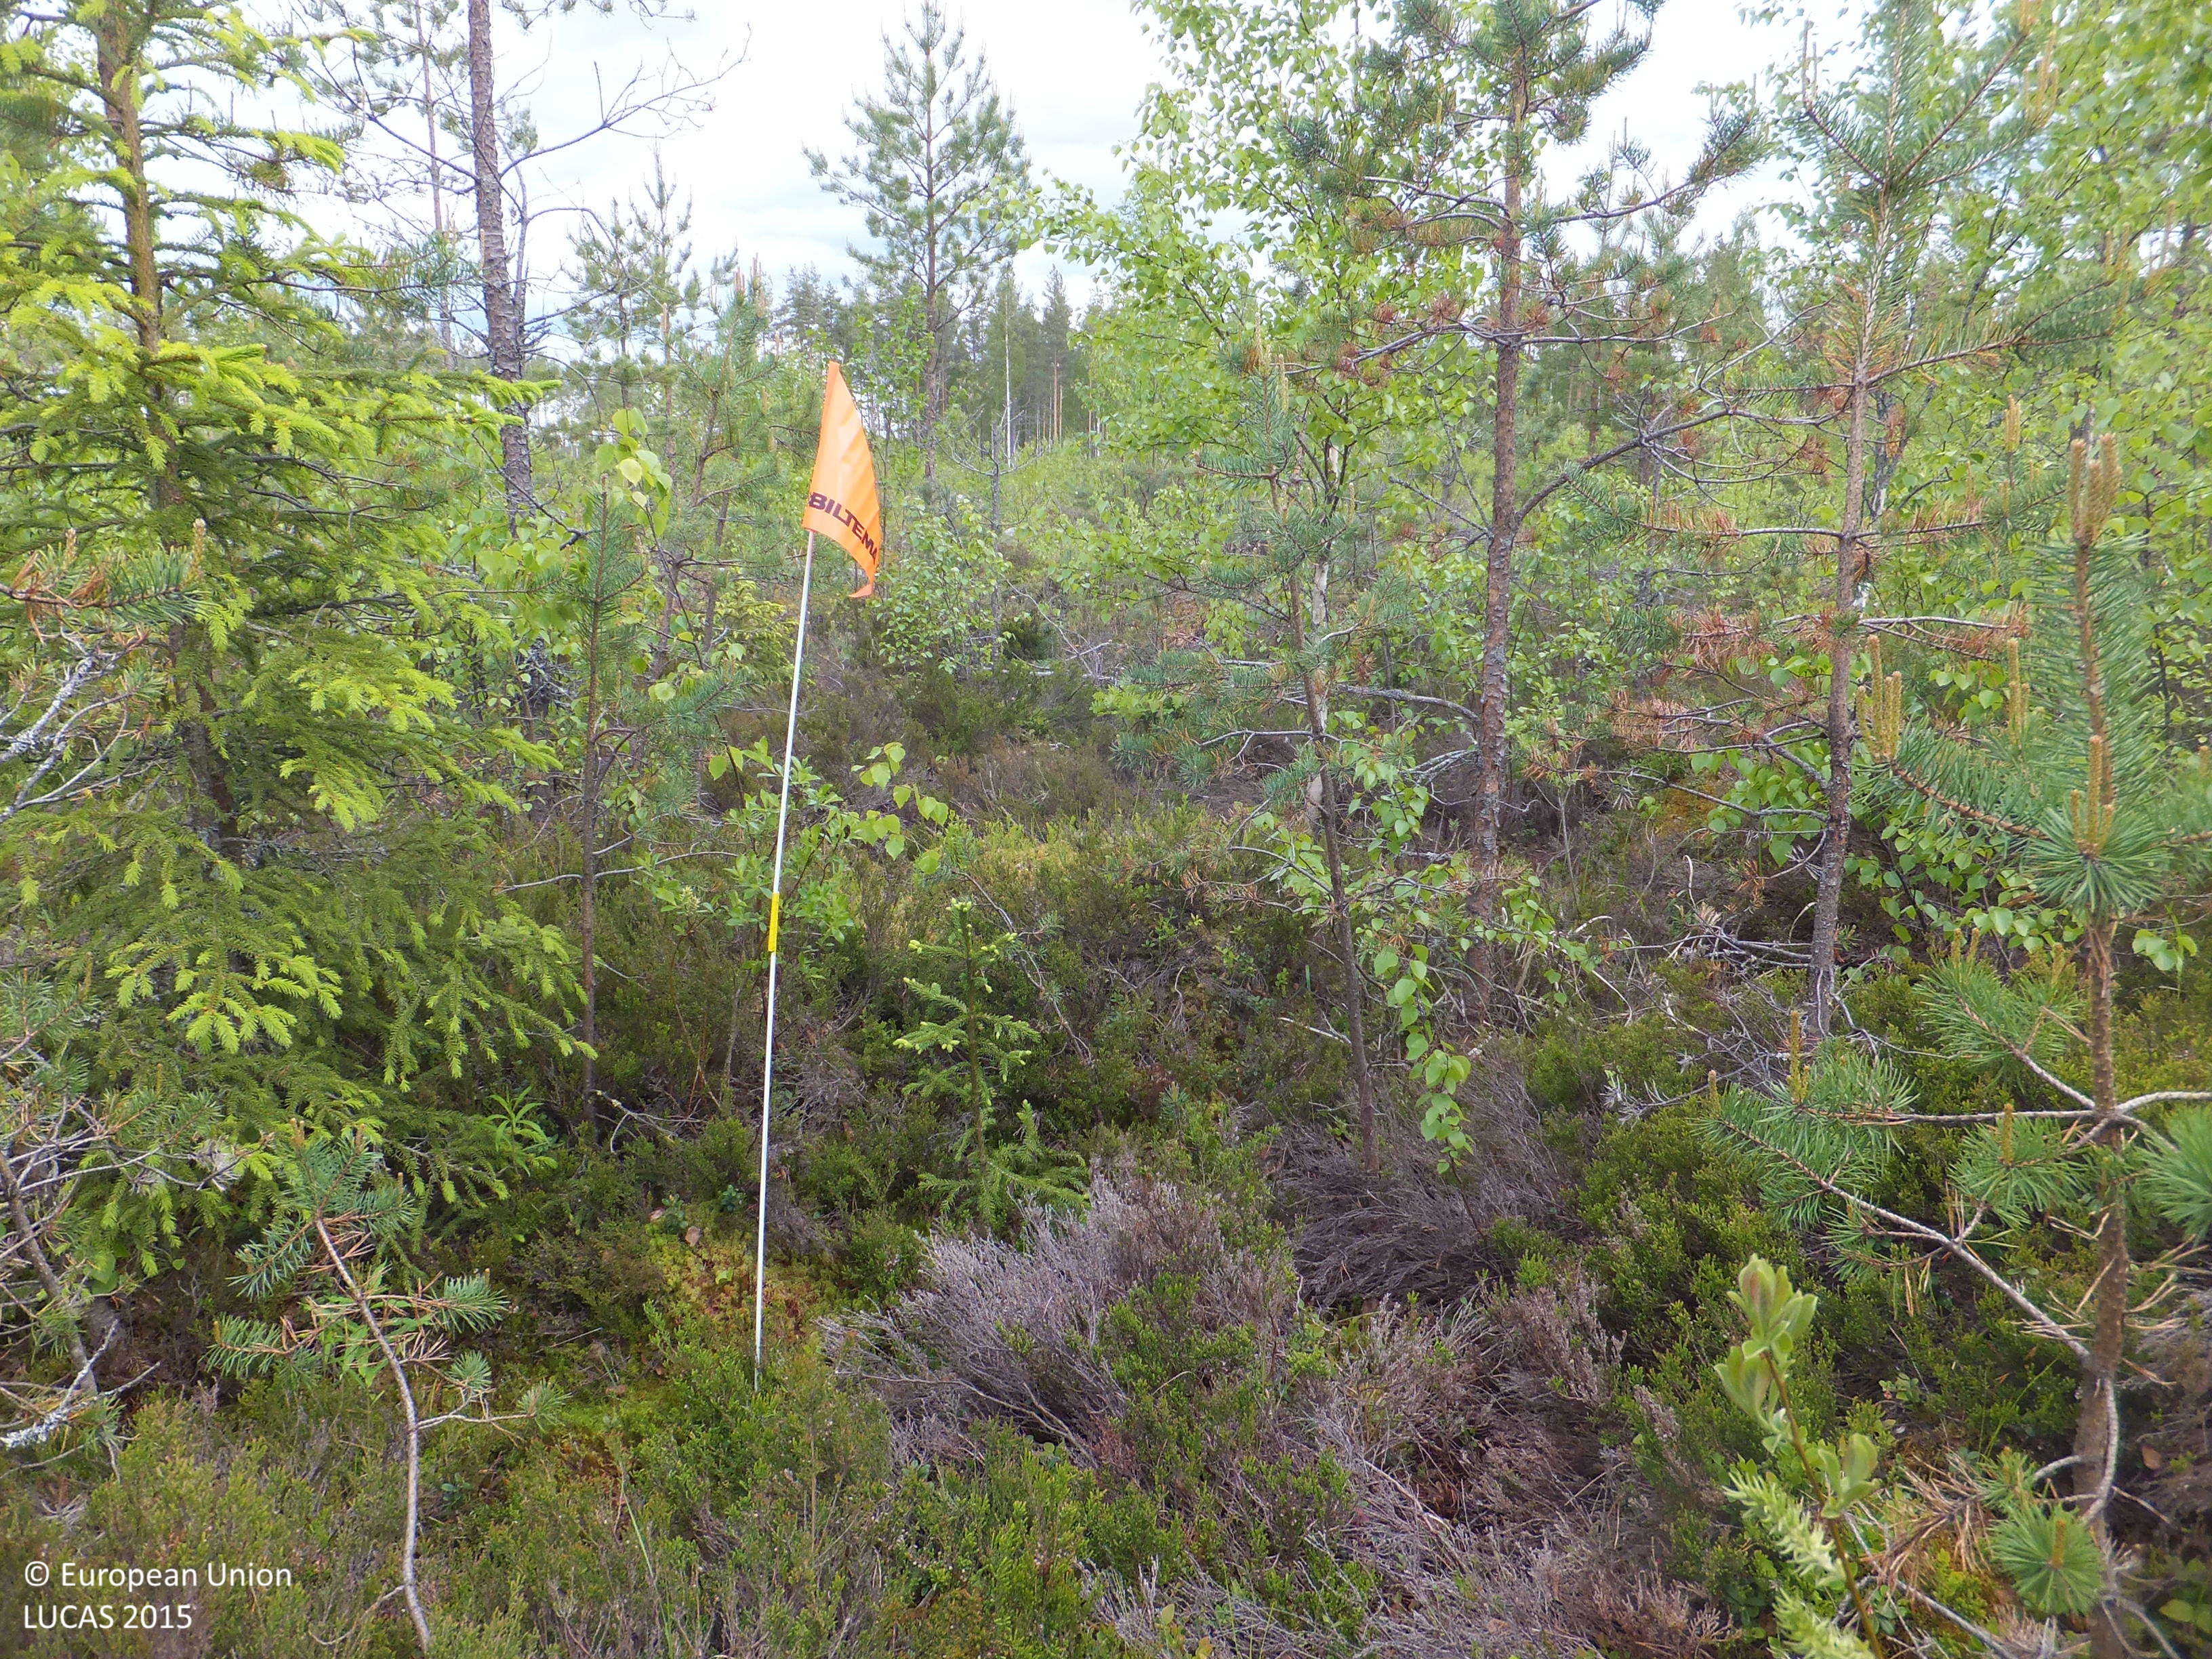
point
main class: Woodland
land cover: Pine dominated mixed woodland
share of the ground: 50 - 75 %
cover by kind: coniferous forest trees 30 %, broadleaved forest trees 30 %, shrubs 30 %, herbaceous plants 10 %
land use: Forestry
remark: Clear cut
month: June
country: FI
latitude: 63.6871
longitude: 24.5361
